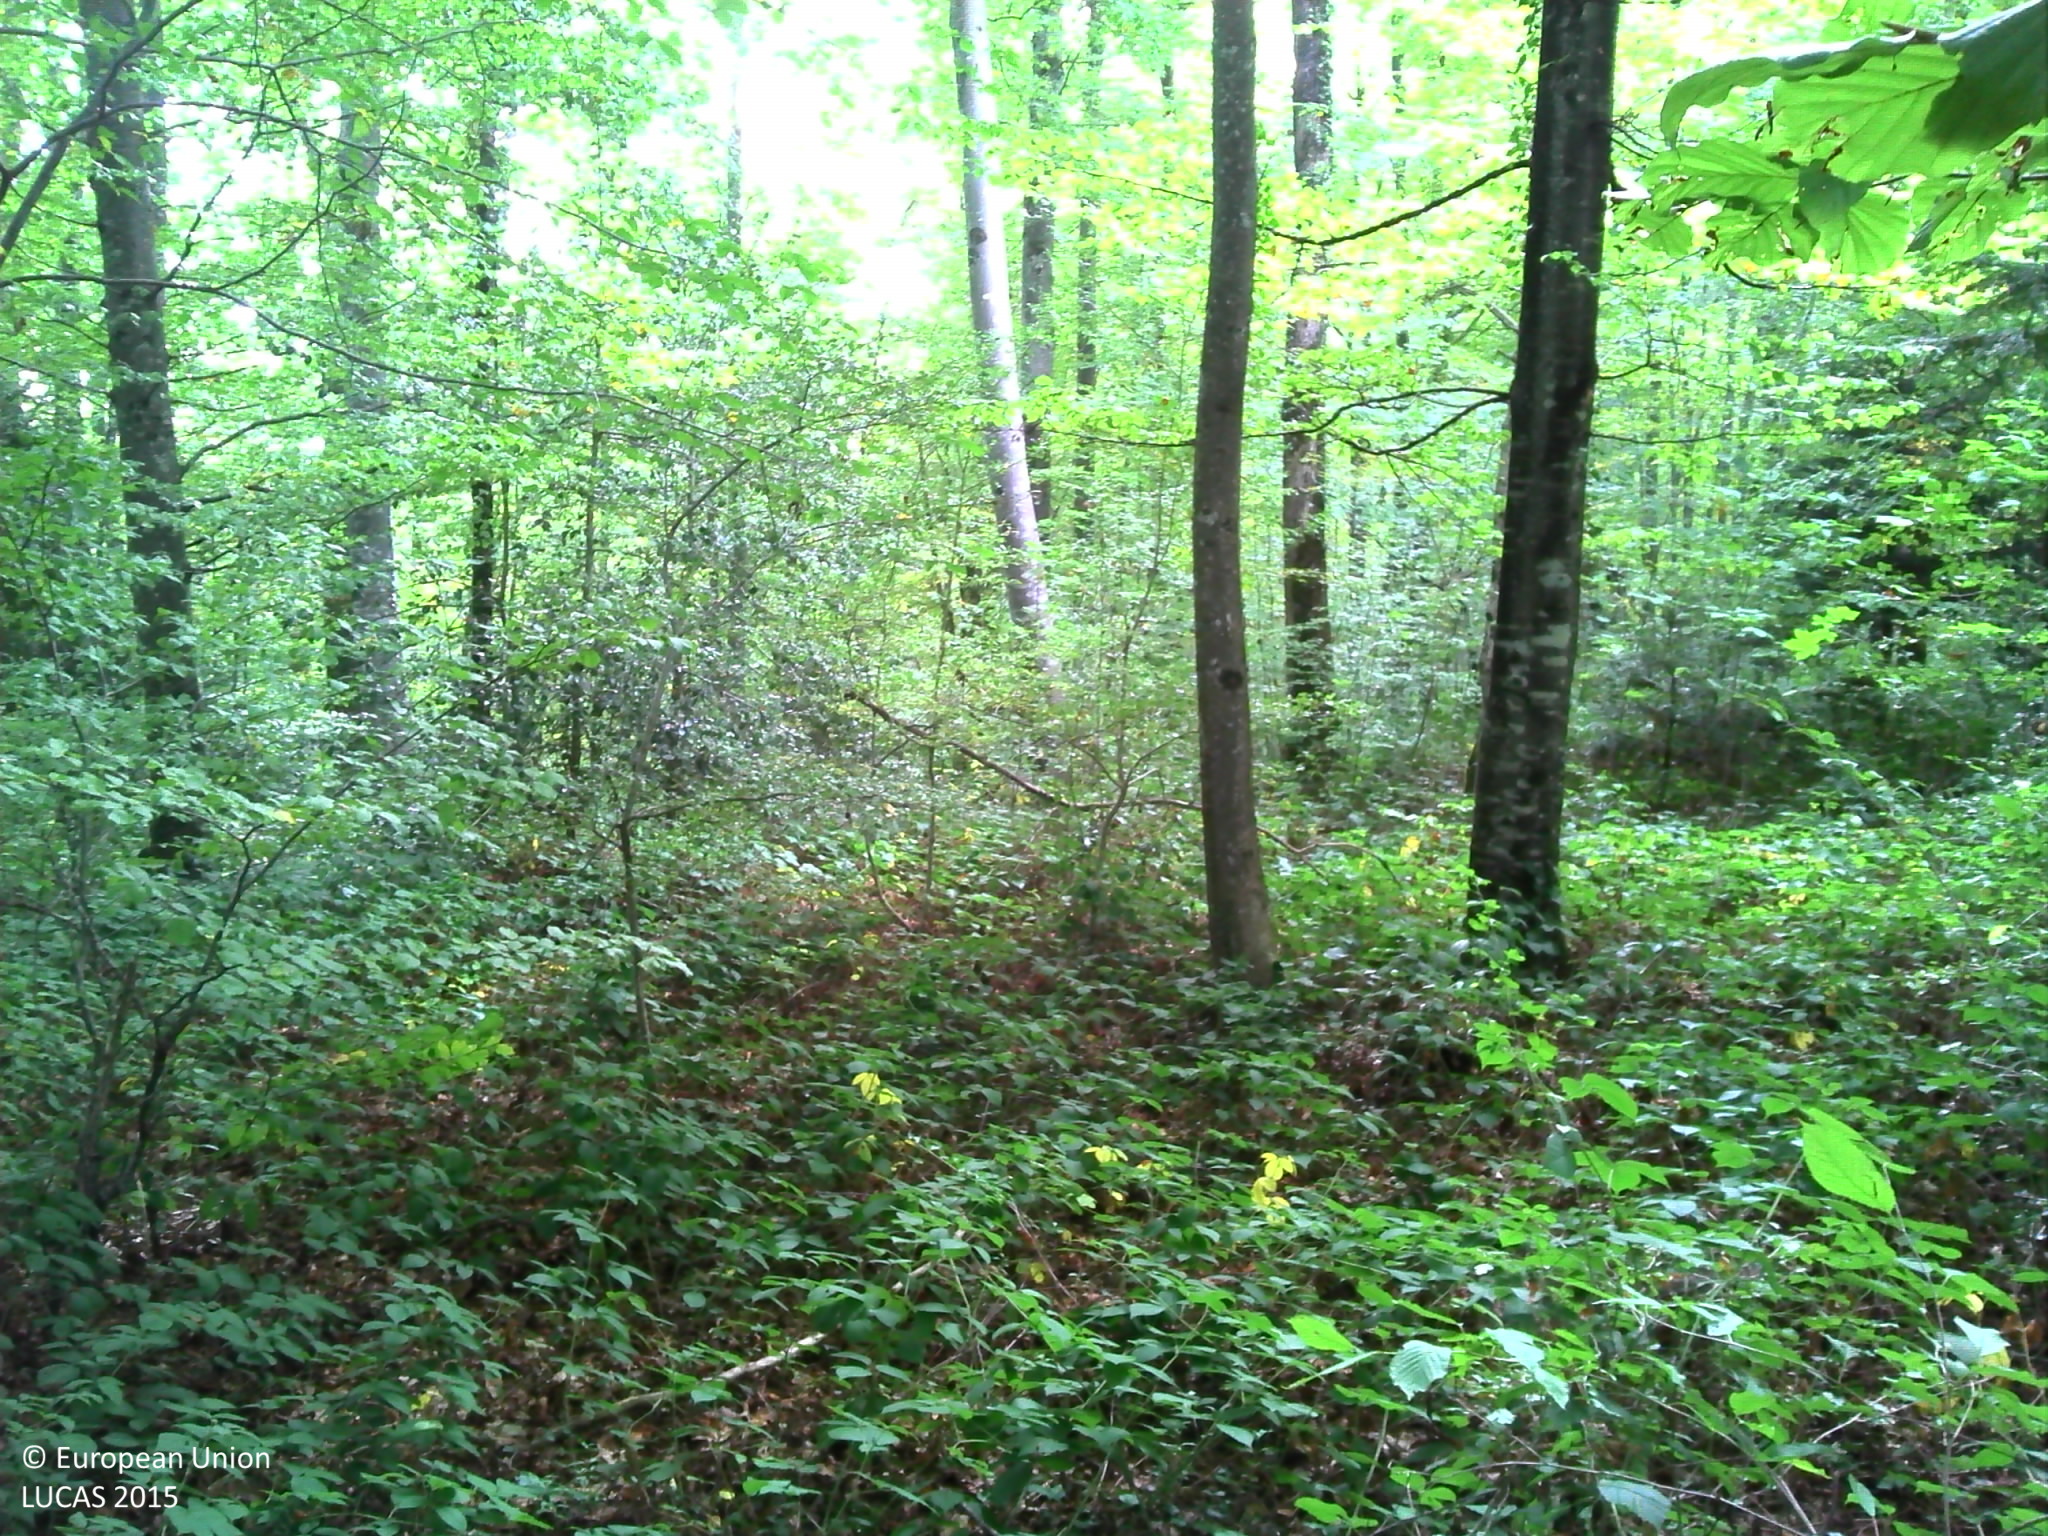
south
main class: Woodland
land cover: Broadleaved woodland
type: beech forest
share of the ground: > 75 %
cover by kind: broadleaved forest trees 90 %, herbaceous plants 5 %, unconsolidated bare surface 5 %
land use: Forestry
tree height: > 5 m
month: October
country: FR
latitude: 47.0749
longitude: 6.1434
